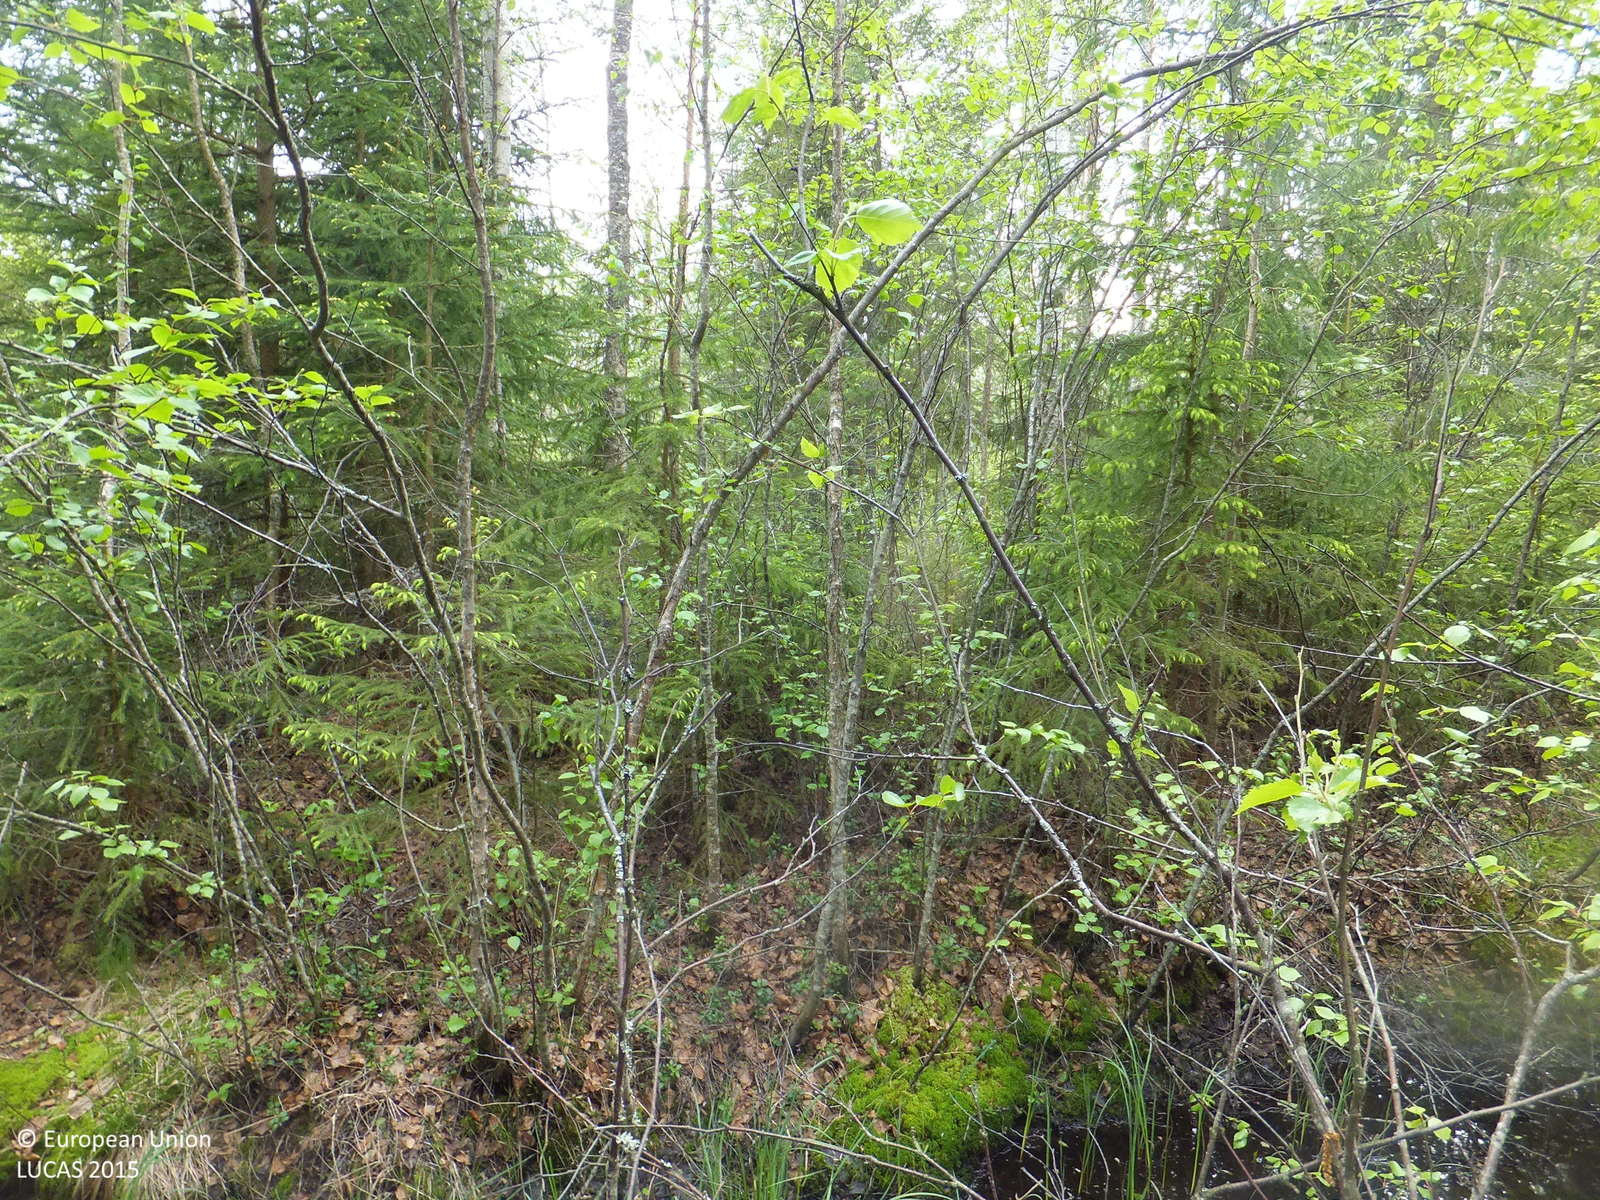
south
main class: Woodland
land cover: Spruce dominated mixed woodland
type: boreal forest
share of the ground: 50 - 75 %
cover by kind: broadleaved forest trees 50 %, shrubs 30 %, coniferous forest trees 20 %
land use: Forestry
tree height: > 5 m
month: June
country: FI
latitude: 63.5129
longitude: 22.3240
